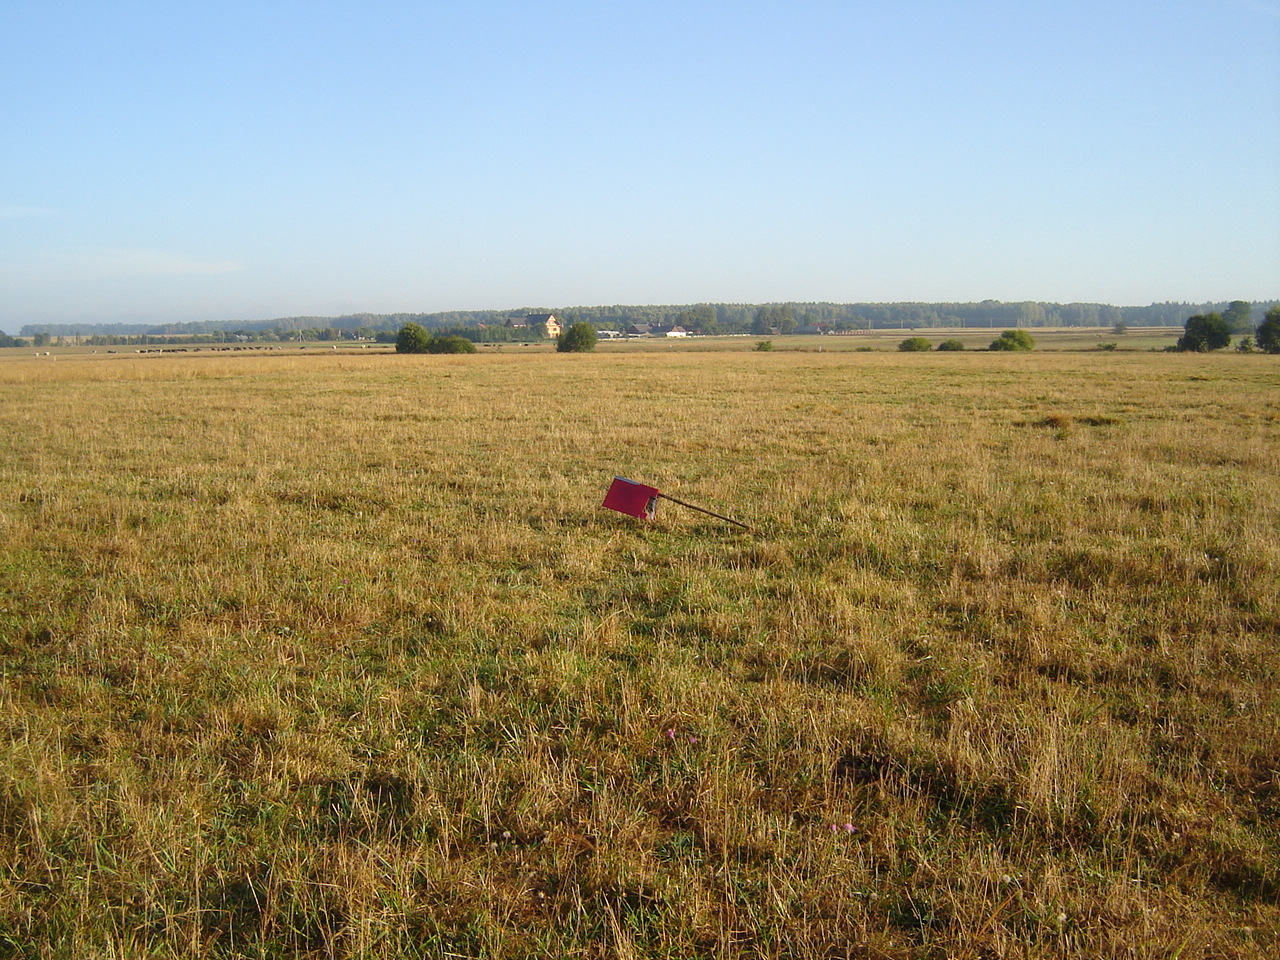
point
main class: Grassland
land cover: Grassland without tree/shrub cover
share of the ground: > 75 %
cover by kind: herbaceous plants 100 %
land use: Agriculture (excluding fallow land and kitchen gardens)
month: September
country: LT
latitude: 54.2383
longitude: 24.9827
